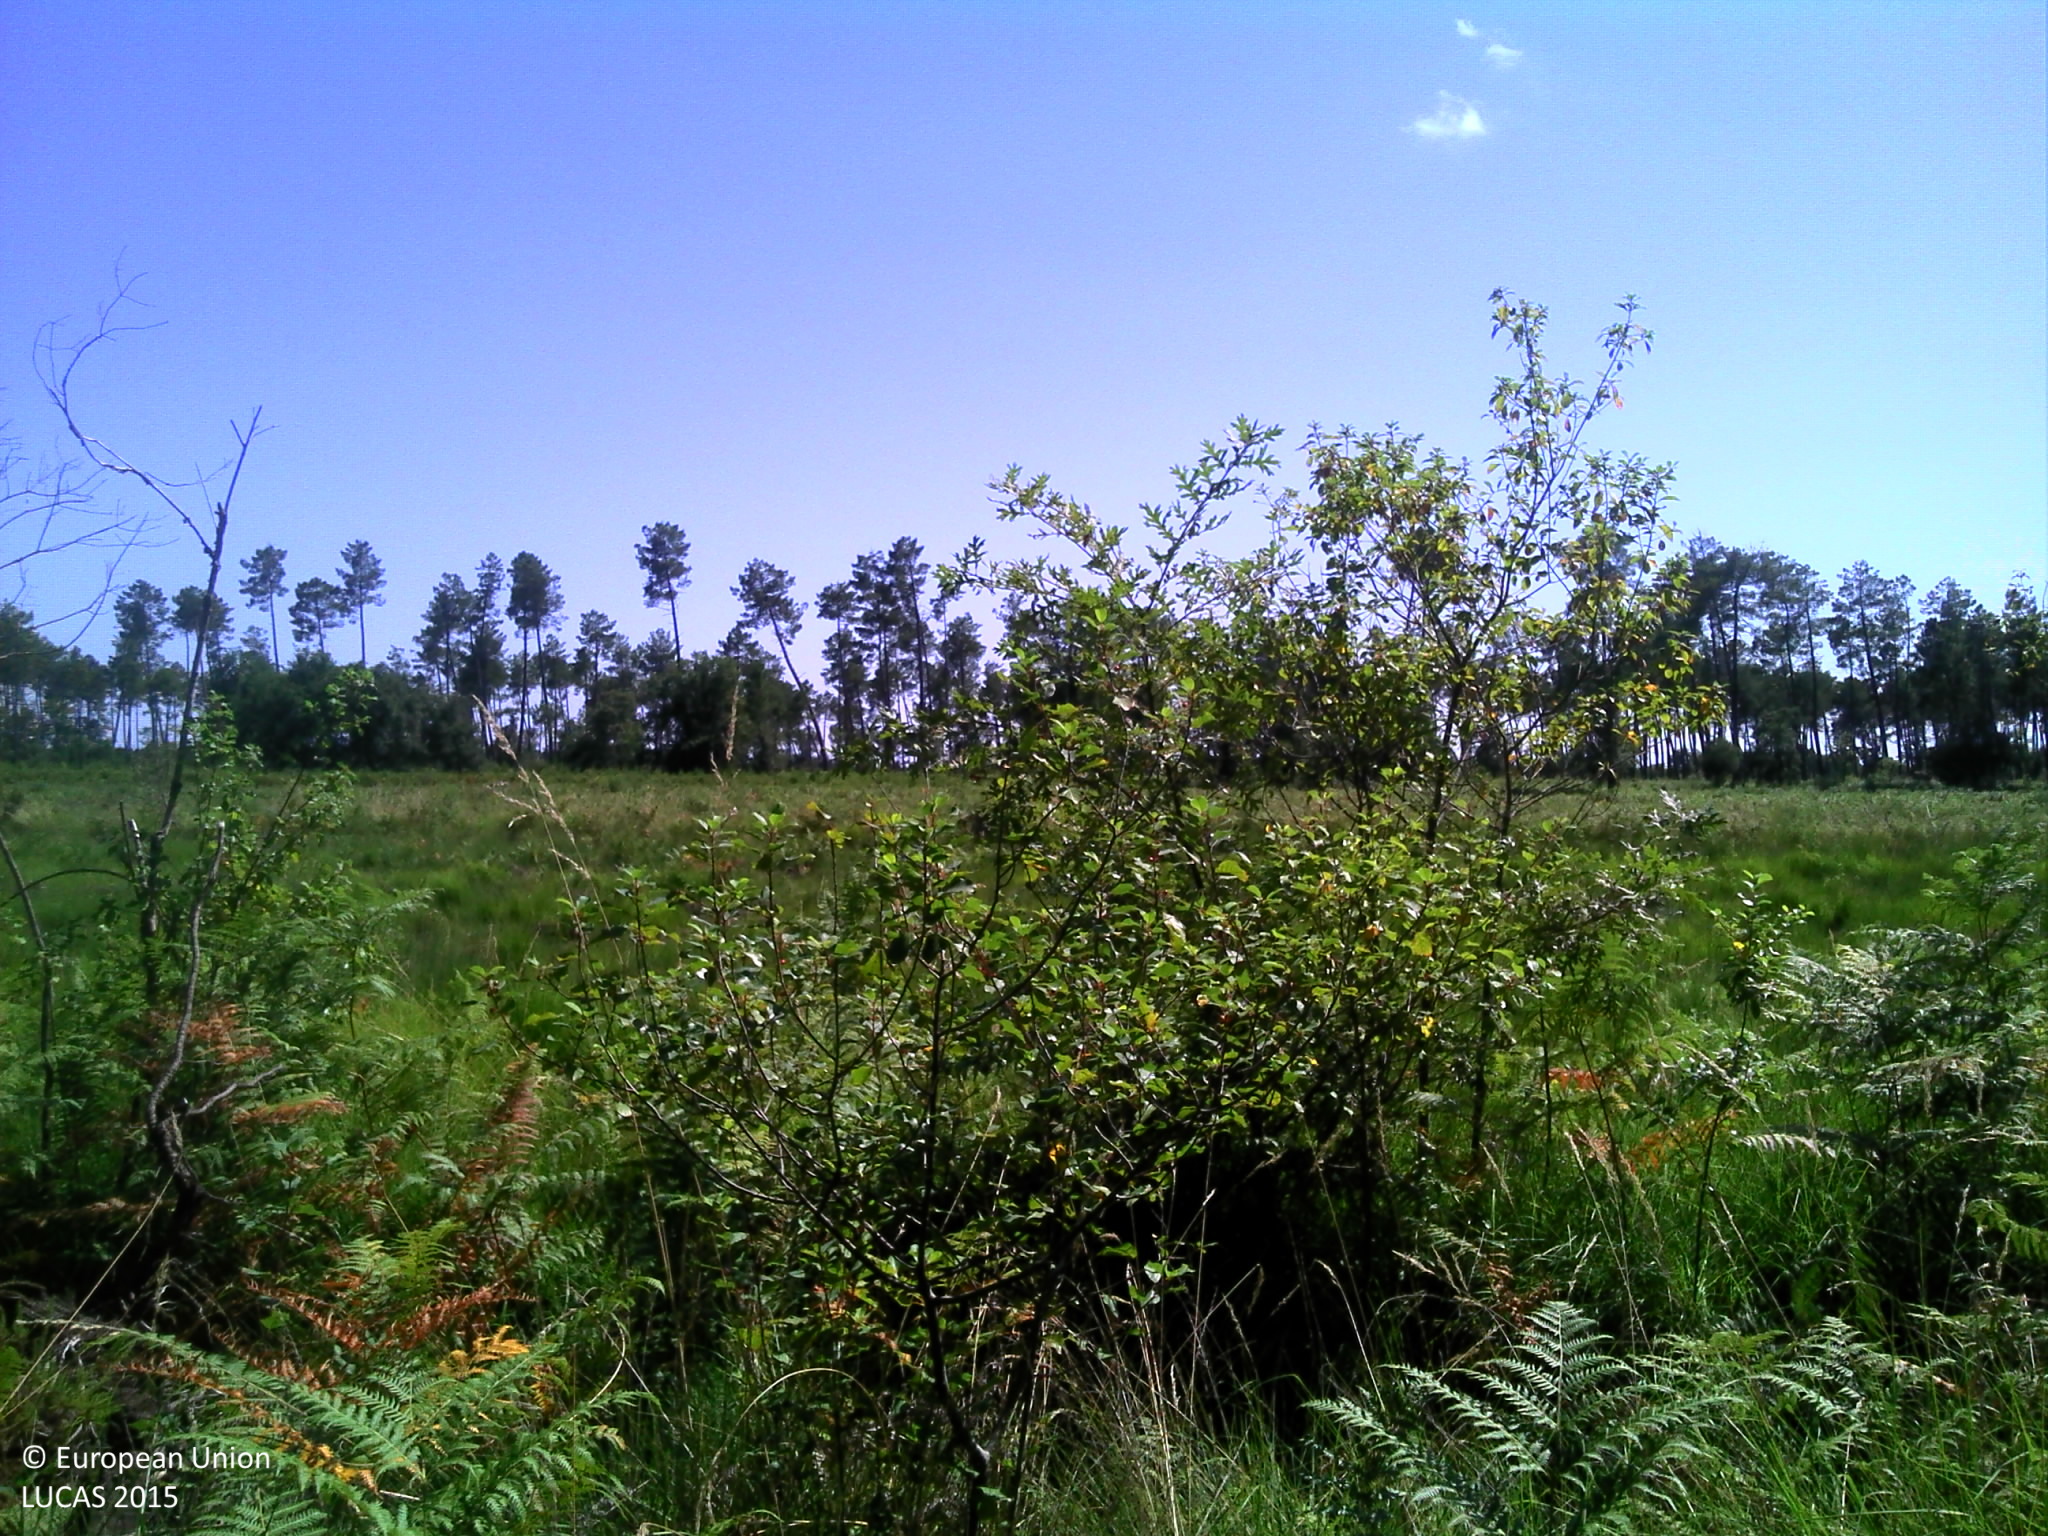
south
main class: Woodland
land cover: Pine dominated coniferous woodland
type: coniferous forest of the mediterranean region
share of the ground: > 75 %
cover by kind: coniferous forest trees 80 %, herbaceous plants 20 %
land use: Forestry
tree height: > 5 m
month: July
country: FR
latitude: 44.0033
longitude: -0.6270
